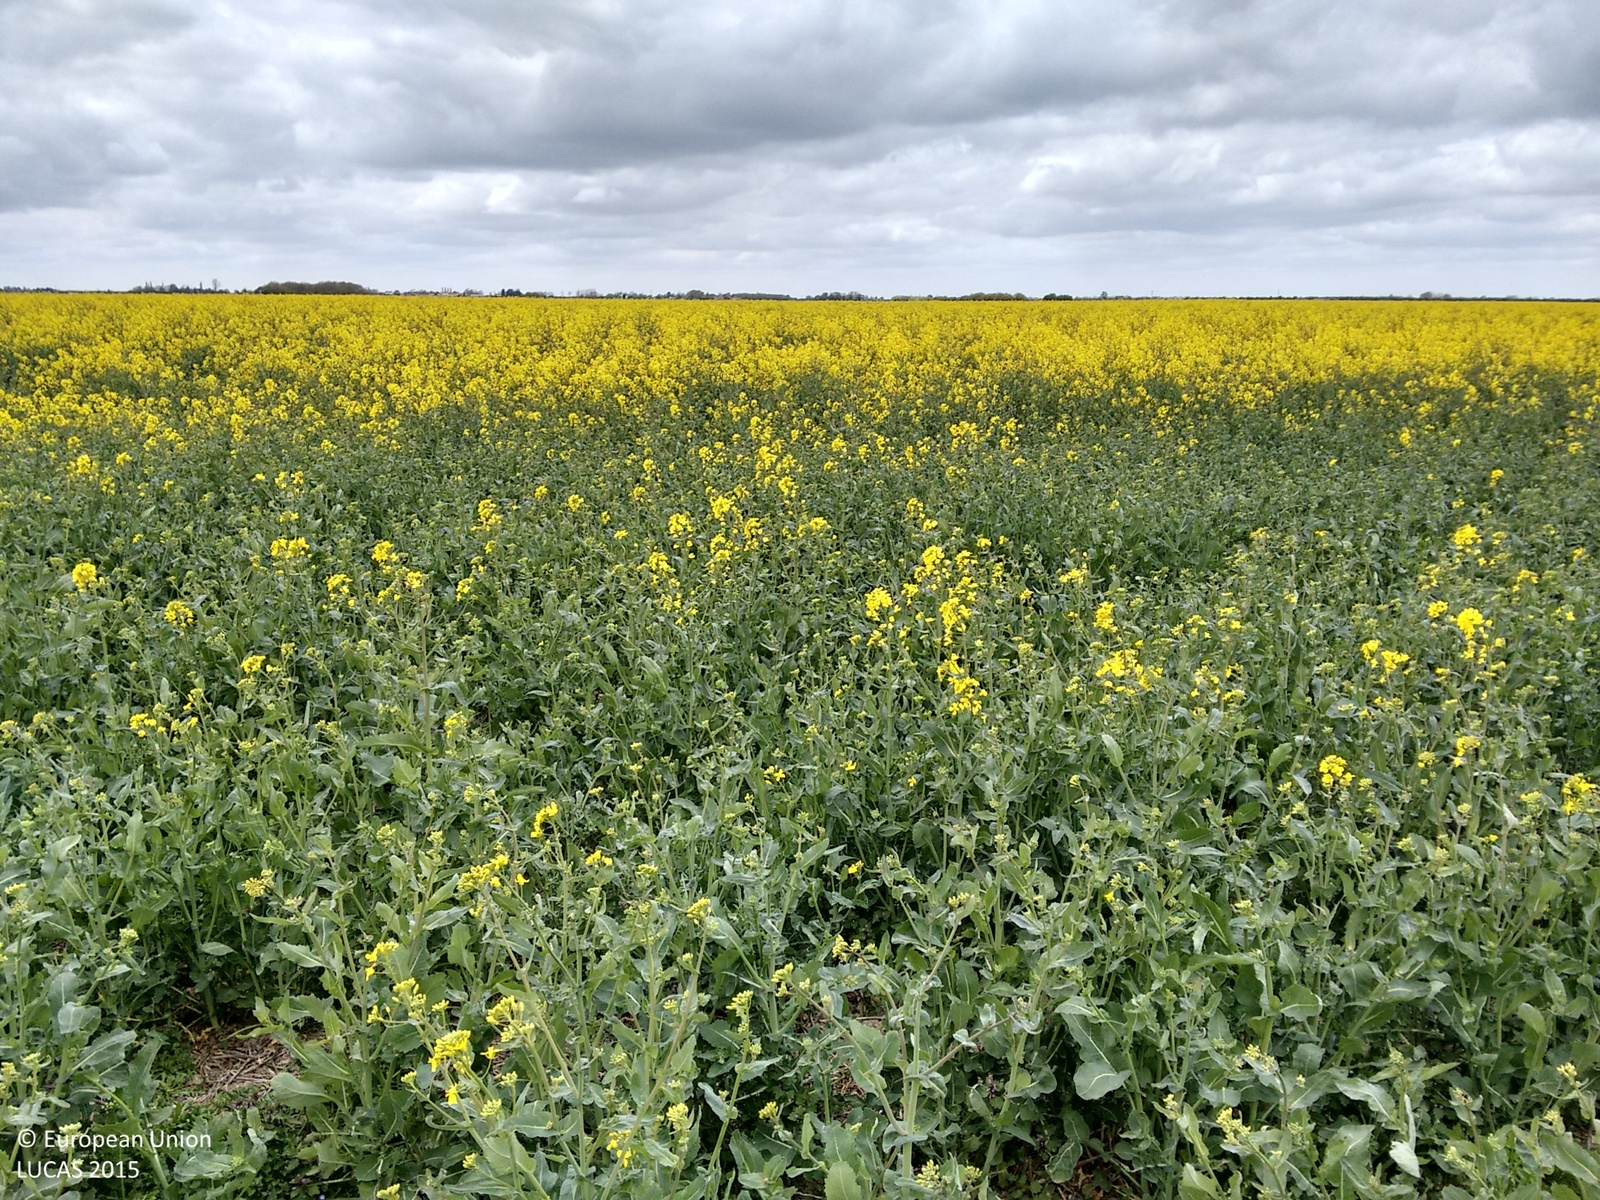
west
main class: Cropland
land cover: Rape and turnip rape
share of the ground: > 75 %
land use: Agriculture (excluding fallow land and kitchen gardens)
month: May
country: GB
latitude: 53.0632
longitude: 0.0449
